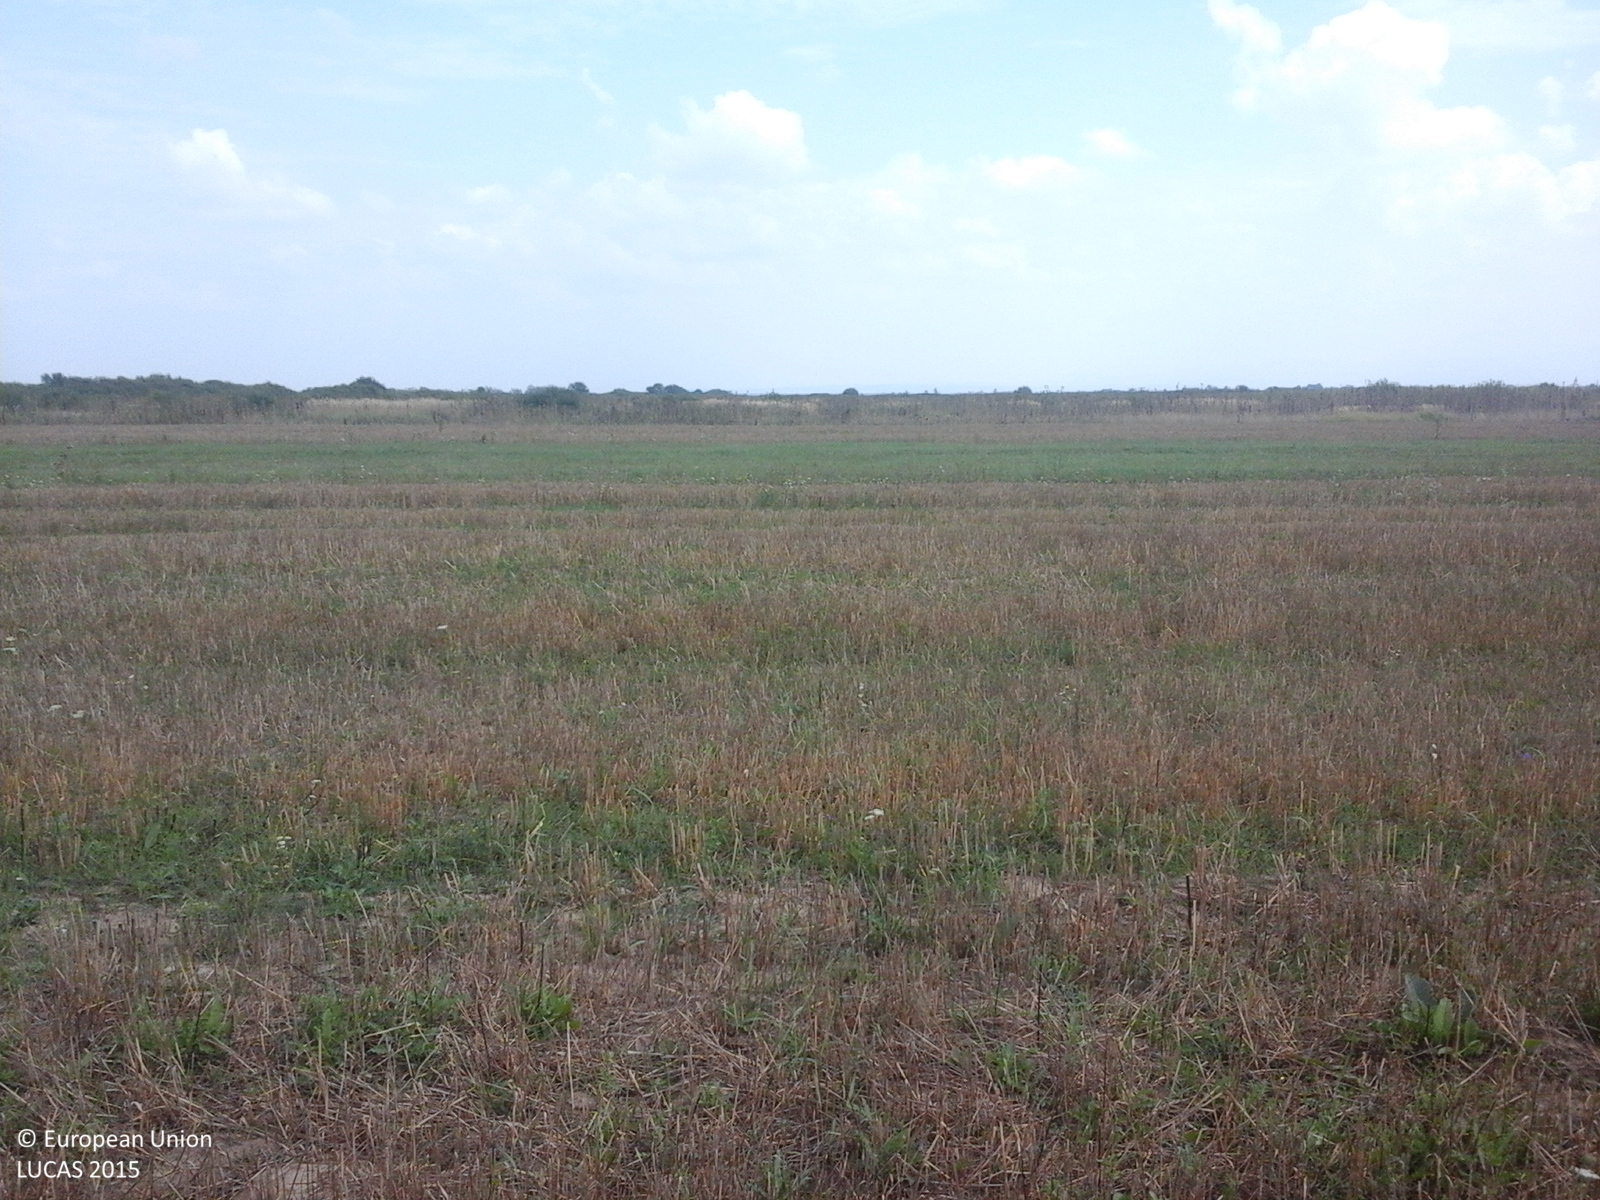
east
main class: Cropland
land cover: Common wheat
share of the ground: 50 - 75 %
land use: Agriculture (excluding fallow land and kitchen gardens)
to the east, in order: Common wheat; Grassland without tree/shrub cover; Common wheat; Spontaneously vegetated surfaces
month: August
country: RO
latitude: 46.6309
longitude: 21.7316
